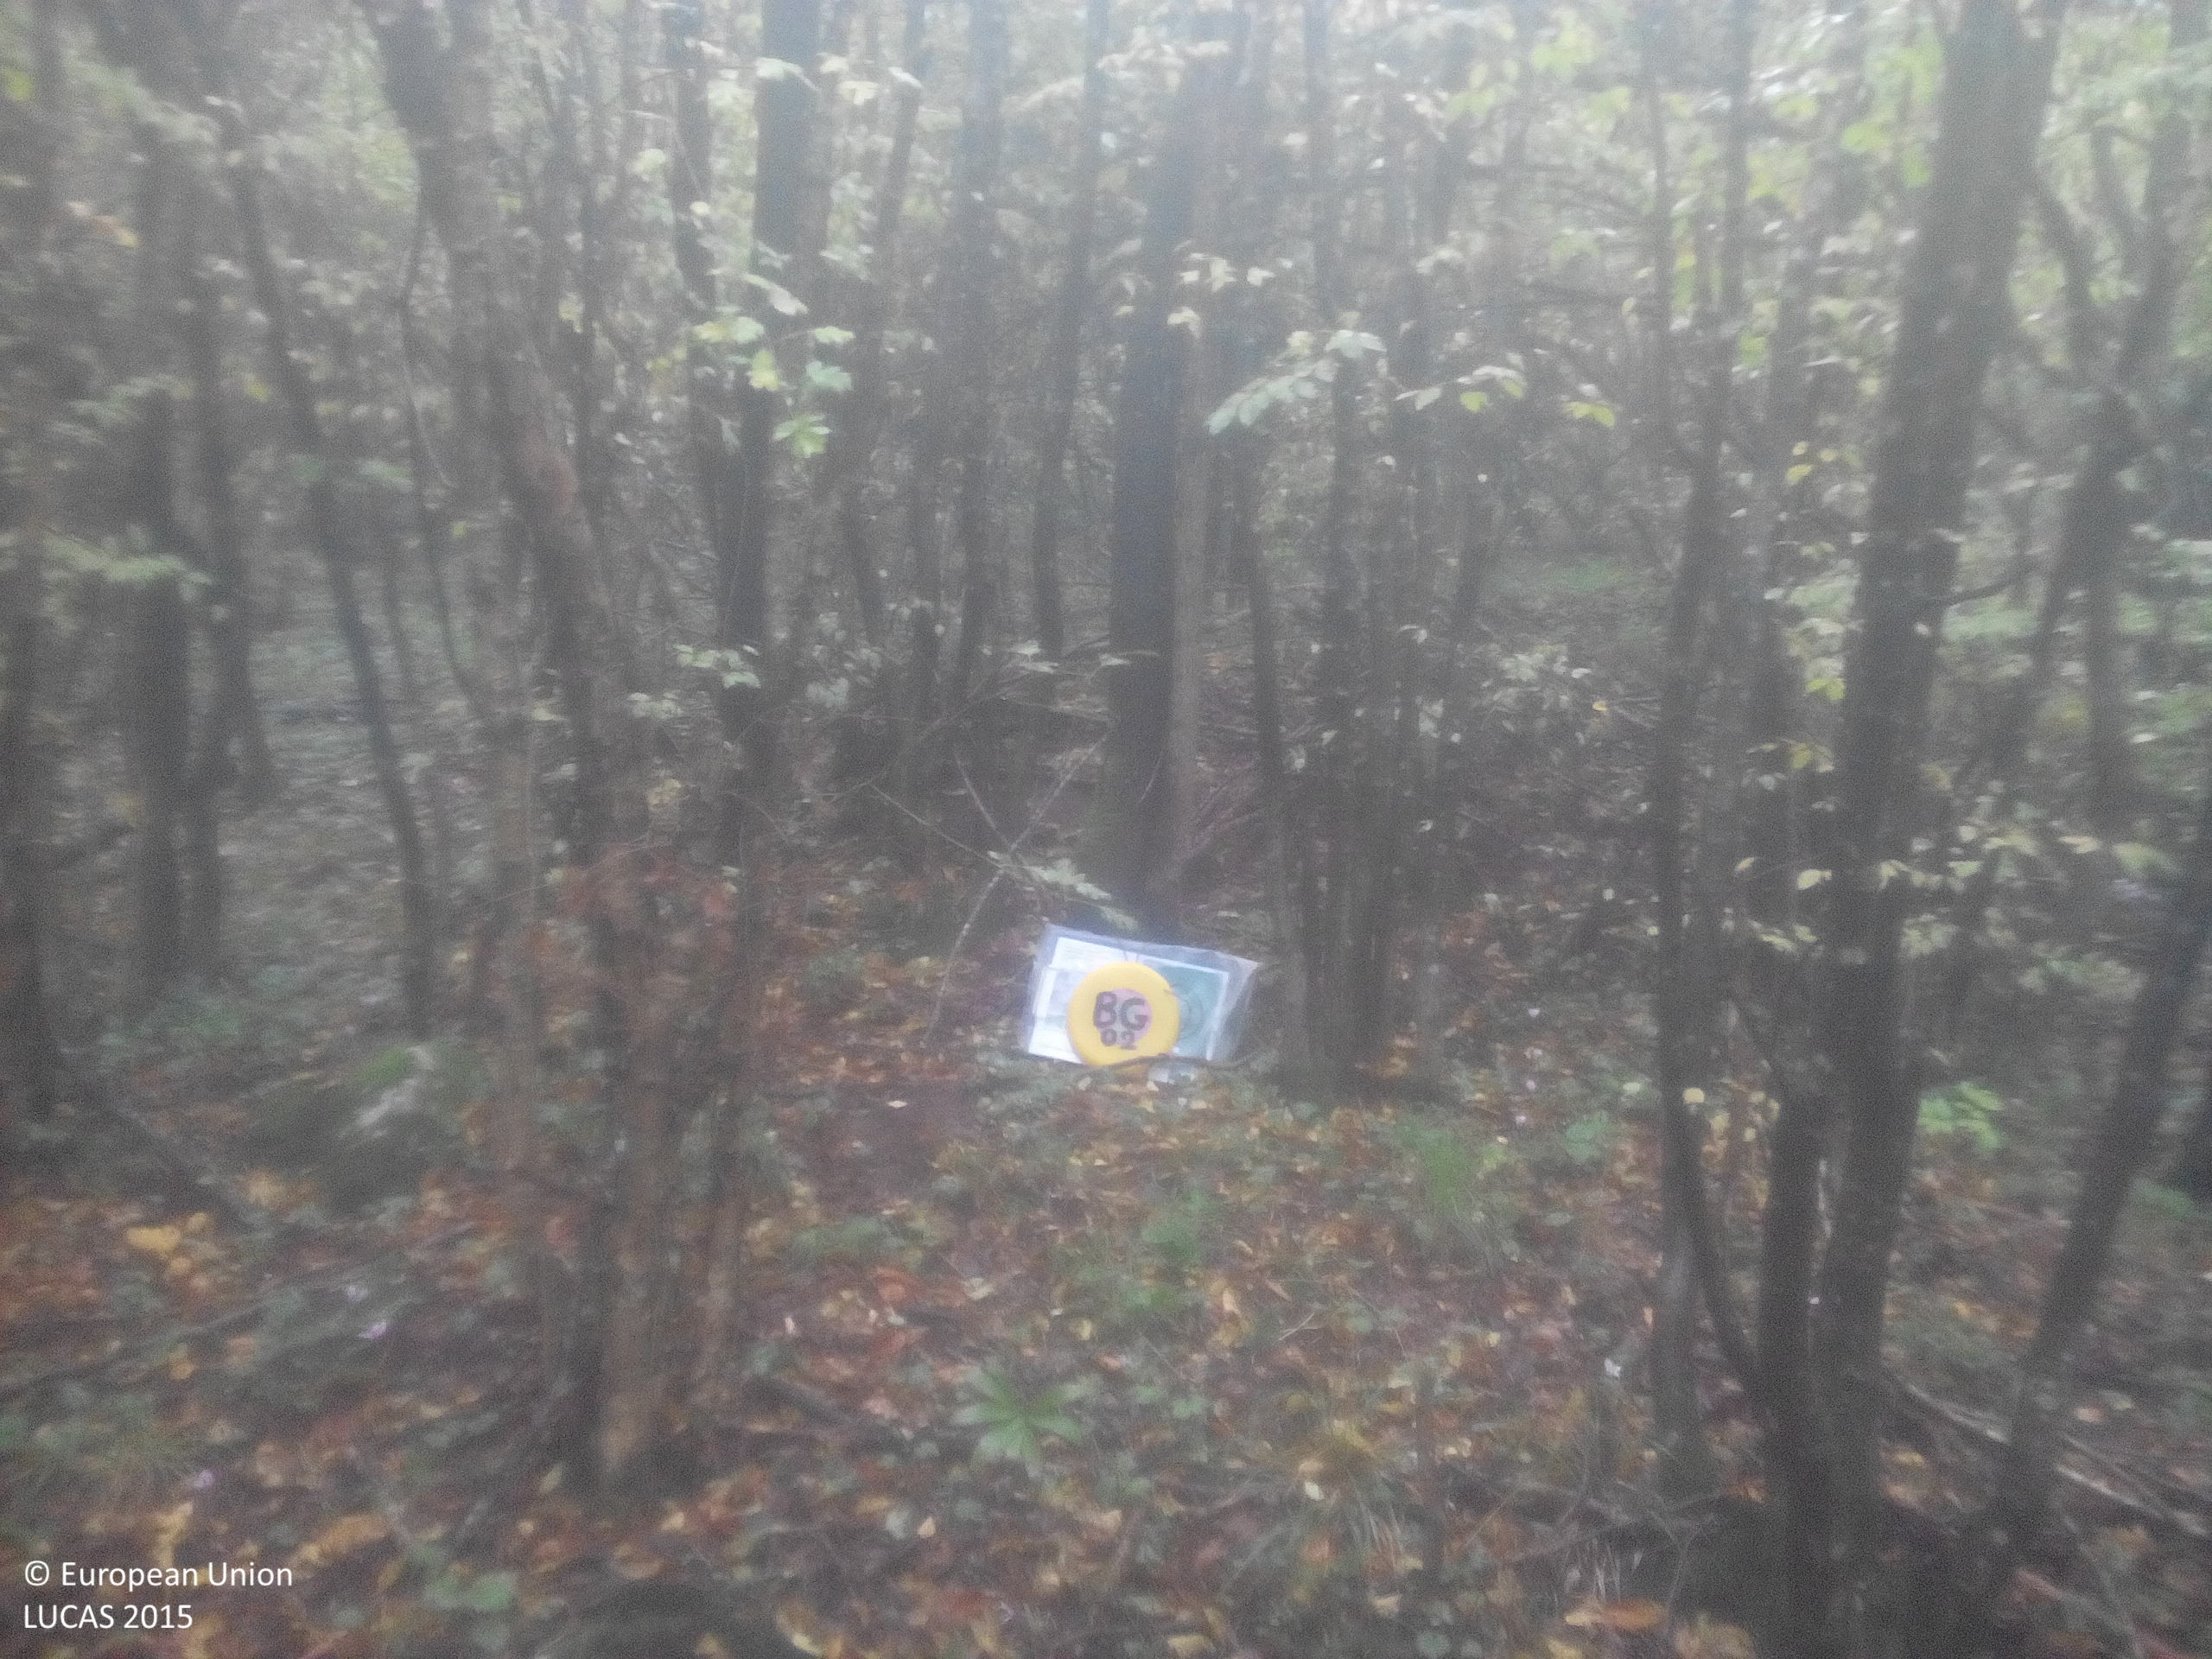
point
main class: Woodland
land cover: Broadleaved woodland
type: beech forest
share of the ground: > 75 %
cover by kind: broadleaved forest trees 100 %
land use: Forestry
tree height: > 5 m
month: October
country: BG
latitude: 43.0485
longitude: 24.1316
